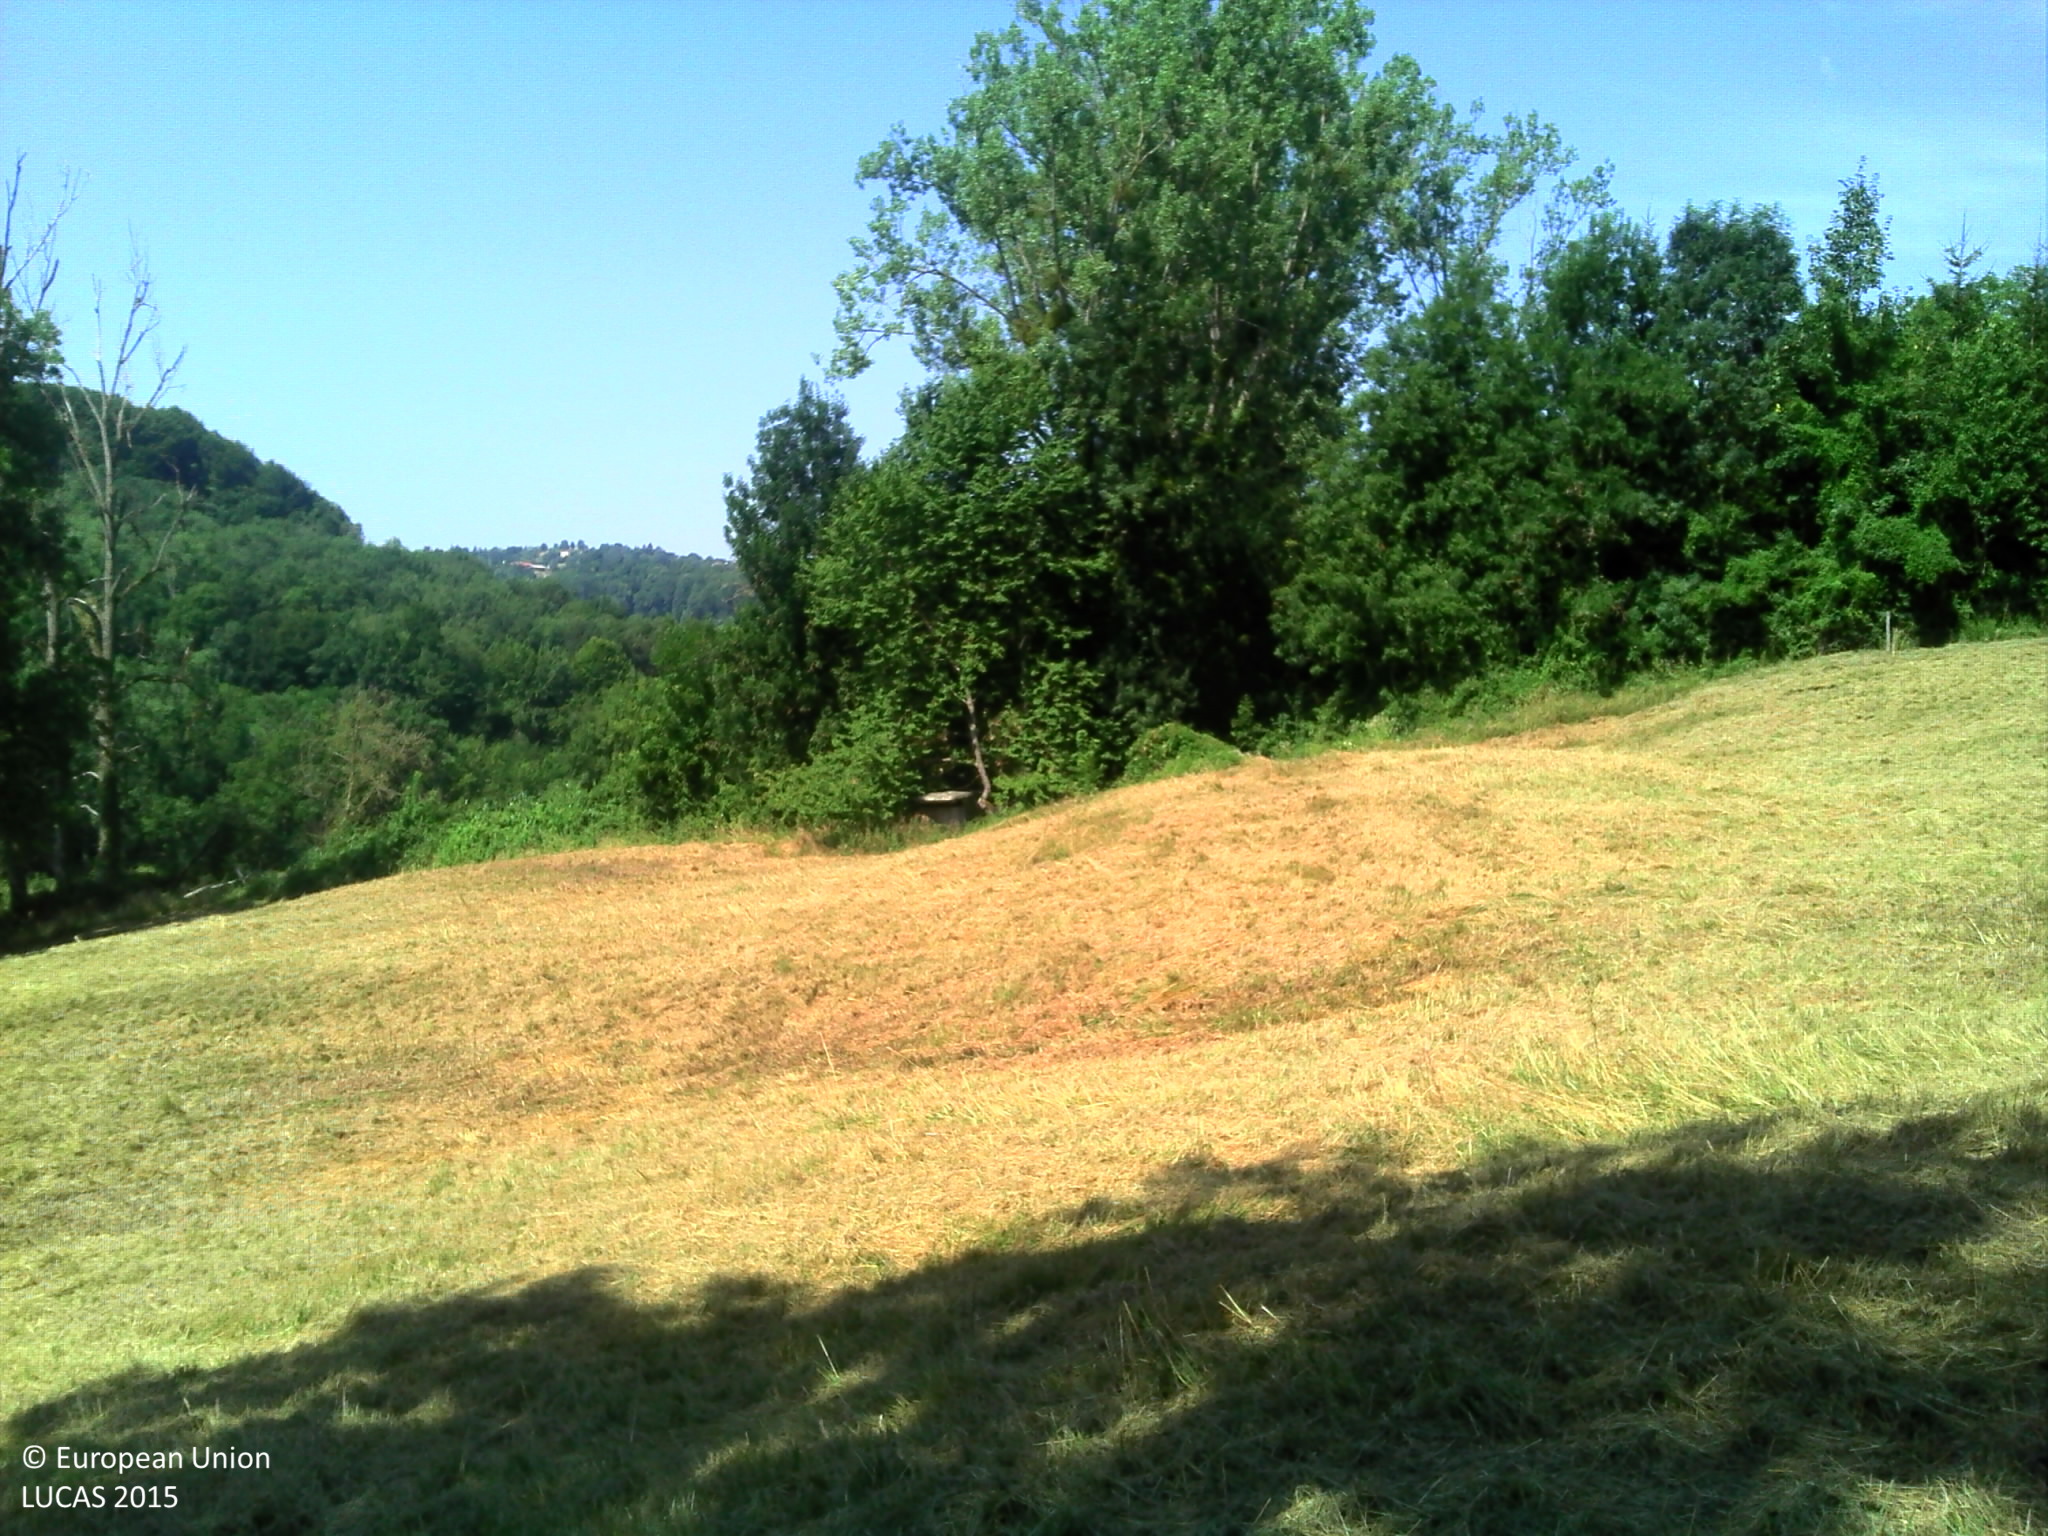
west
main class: Grassland
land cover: Grassland without tree/shrub cover
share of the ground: > 75 %
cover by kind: herbaceous plants 100 %
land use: Agriculture (excluding fallow land and kitchen gardens)
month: July
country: FR
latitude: 45.5455
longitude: 5.3296
